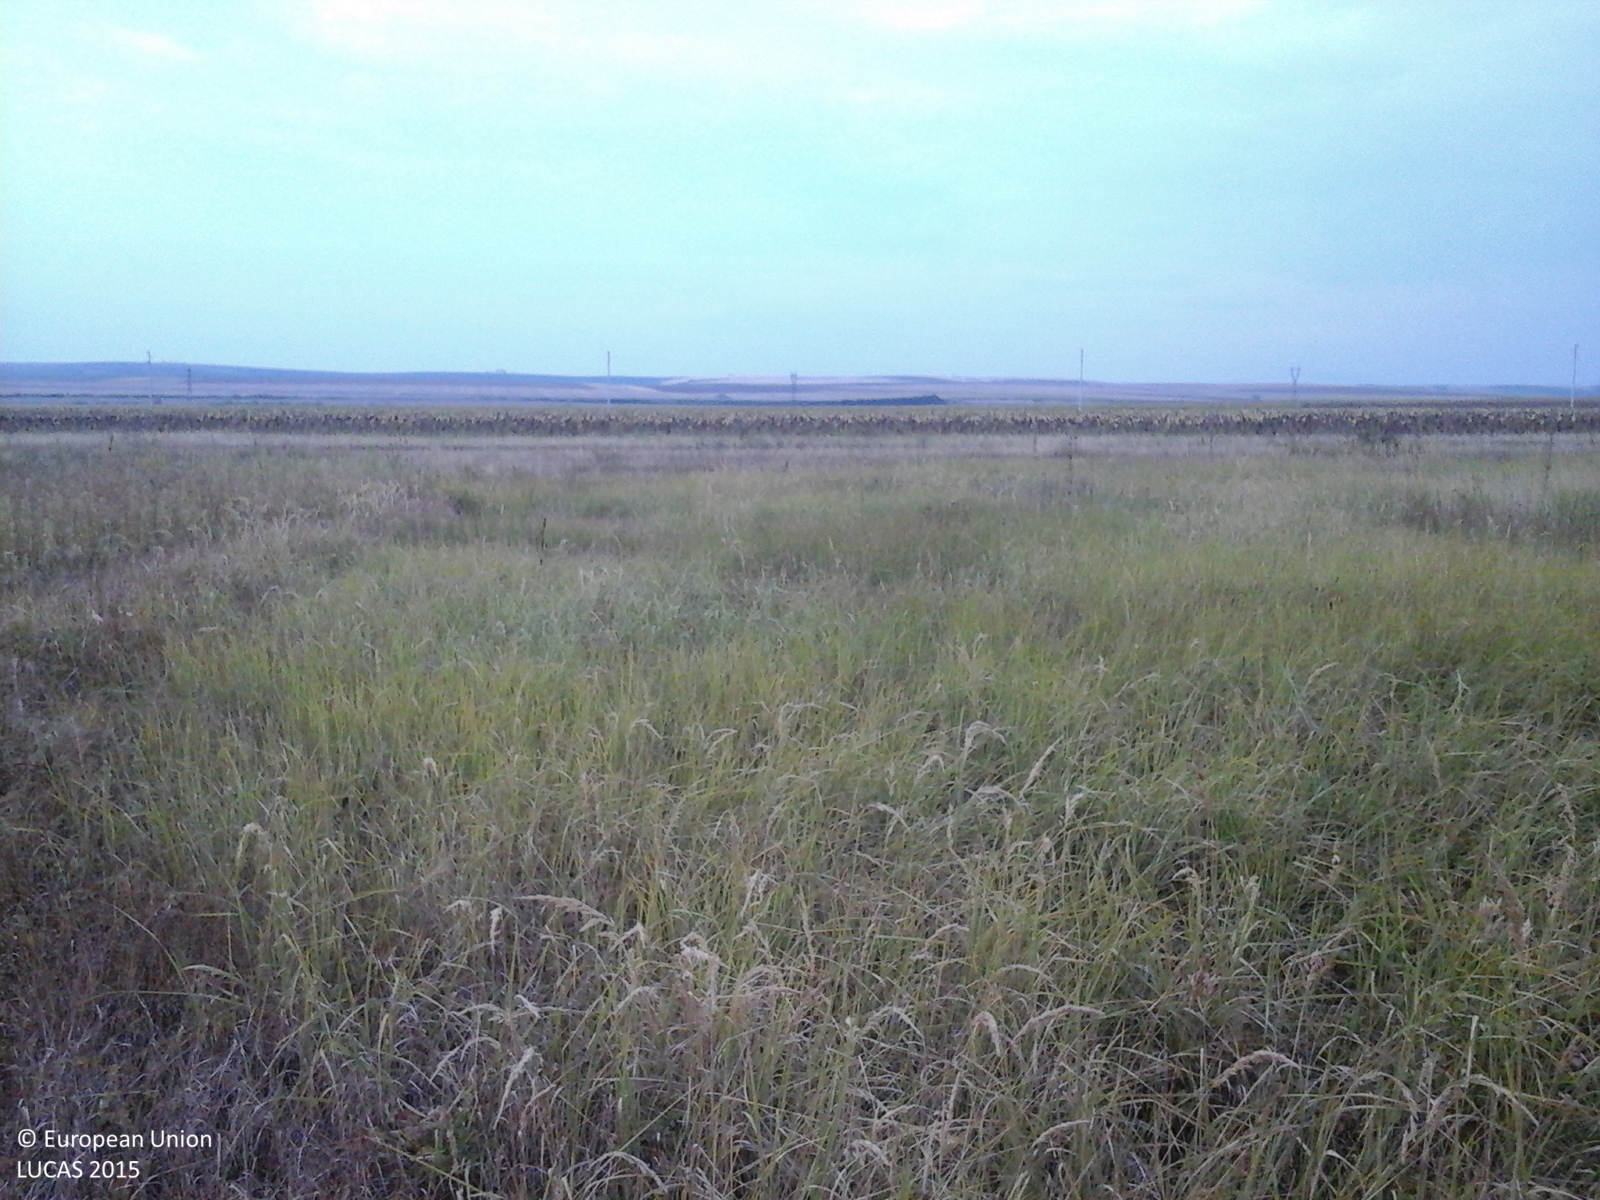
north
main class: Grassland
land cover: Spontaneously vegetated surfaces
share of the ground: > 75 %
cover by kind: herbaceous plants 100 %
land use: Fallow land
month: August
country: RO
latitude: 45.7961
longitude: 21.5490
